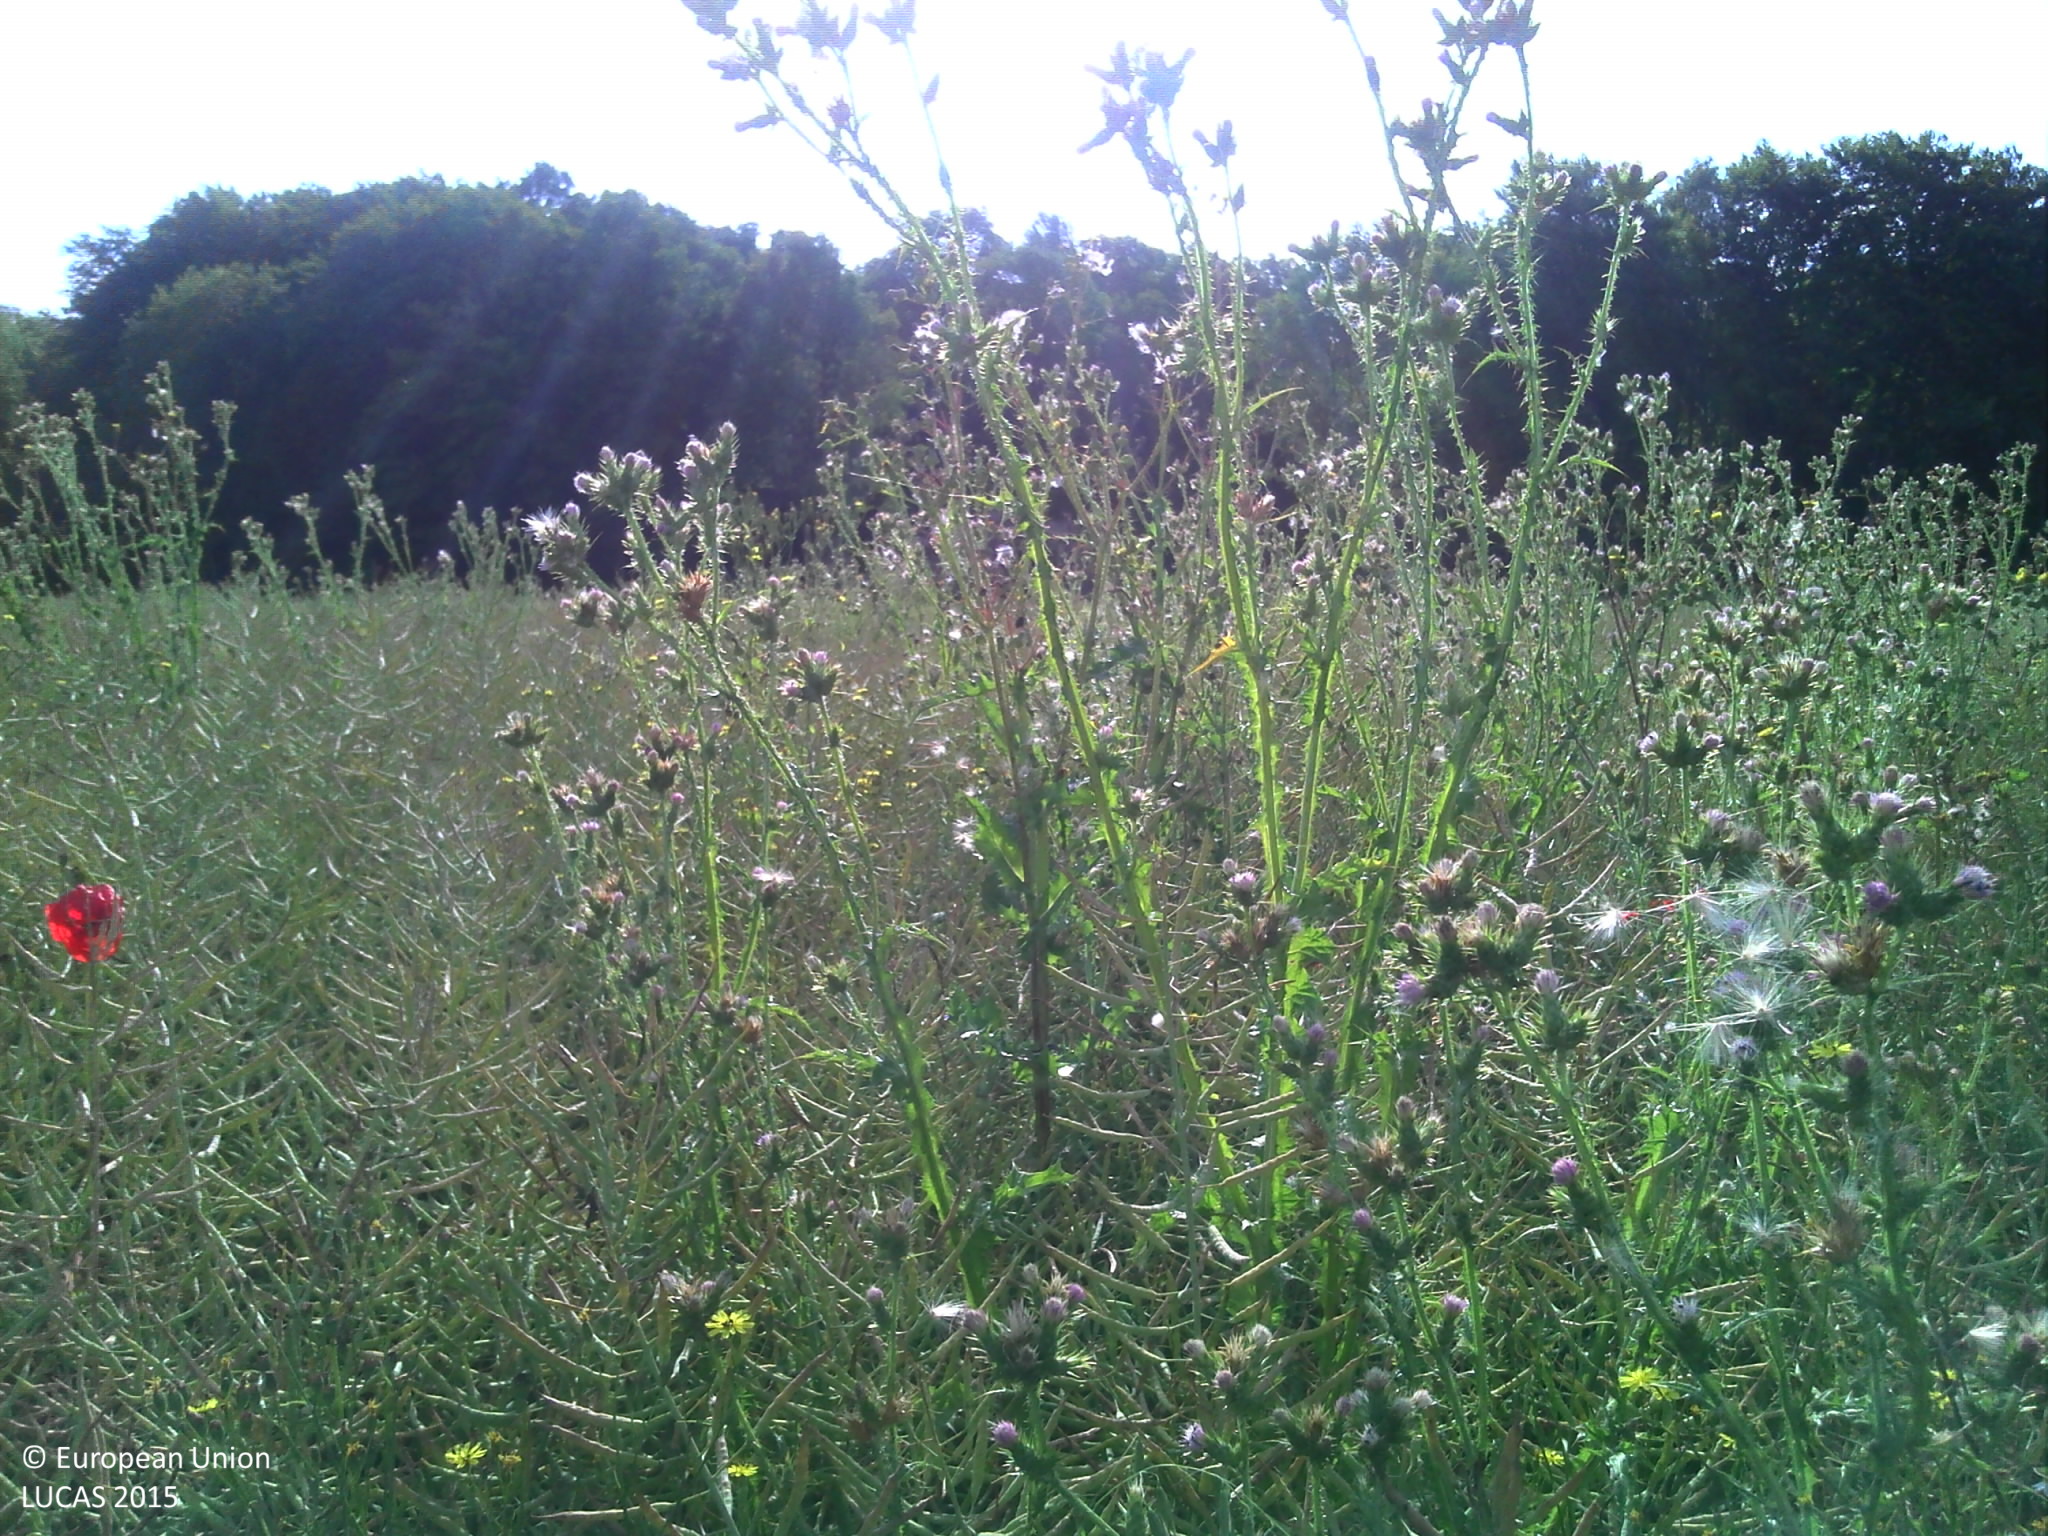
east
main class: Cropland
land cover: Rape and turnip rape
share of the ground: 50 - 75 %
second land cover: Spontaneously vegetated surfaces
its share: 25 - 50 %
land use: Agriculture (excluding fallow land and kitchen gardens)
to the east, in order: Rape and turnip rape; Spontaneously vegetated surfaces; Grass margins; Shrubland without tree cover; Tracks; Broadleaved woodland; Tracks; Broadleaved woodland
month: June
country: FR
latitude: 48.5680
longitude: 5.1606
